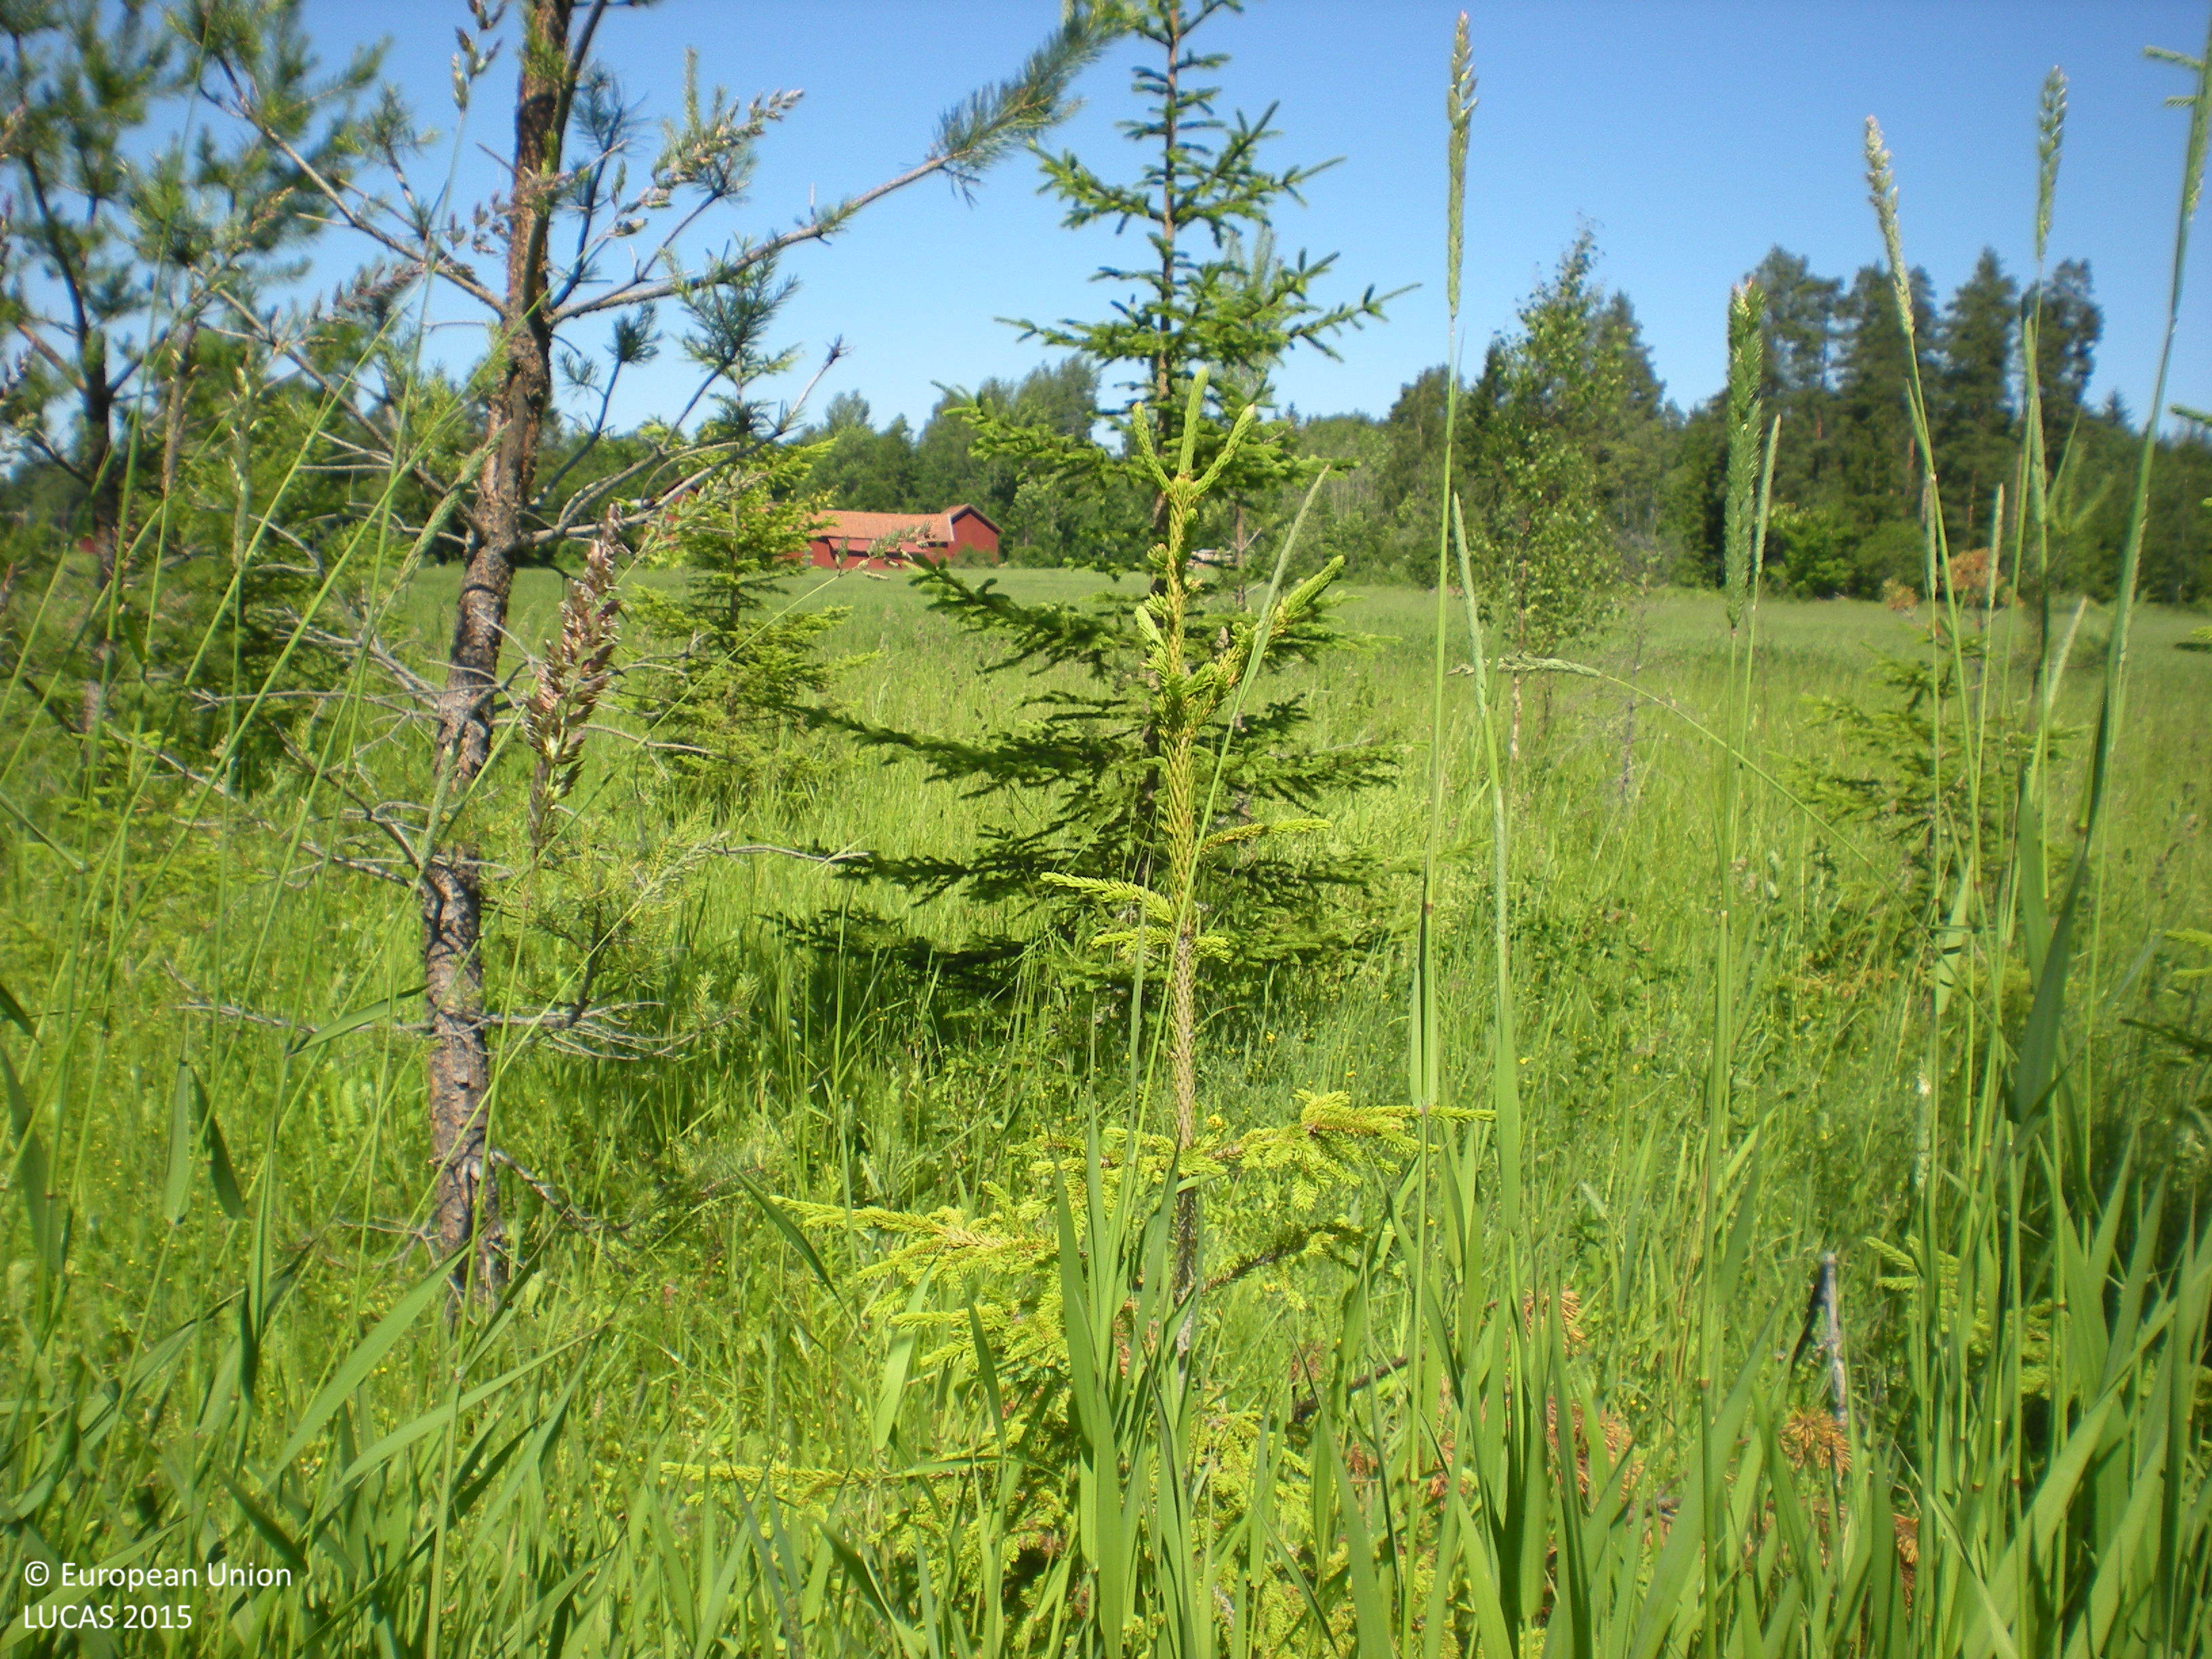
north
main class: Woodland
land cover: Other coniferous woodland
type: boreal forest
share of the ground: 10 - 25 %
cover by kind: herbaceous plants 65 %, coniferous forest trees 35 %
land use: Forestry
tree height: < 5 m
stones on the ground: < 10 %
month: July
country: SE
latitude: 60.4916
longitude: 17.7636
